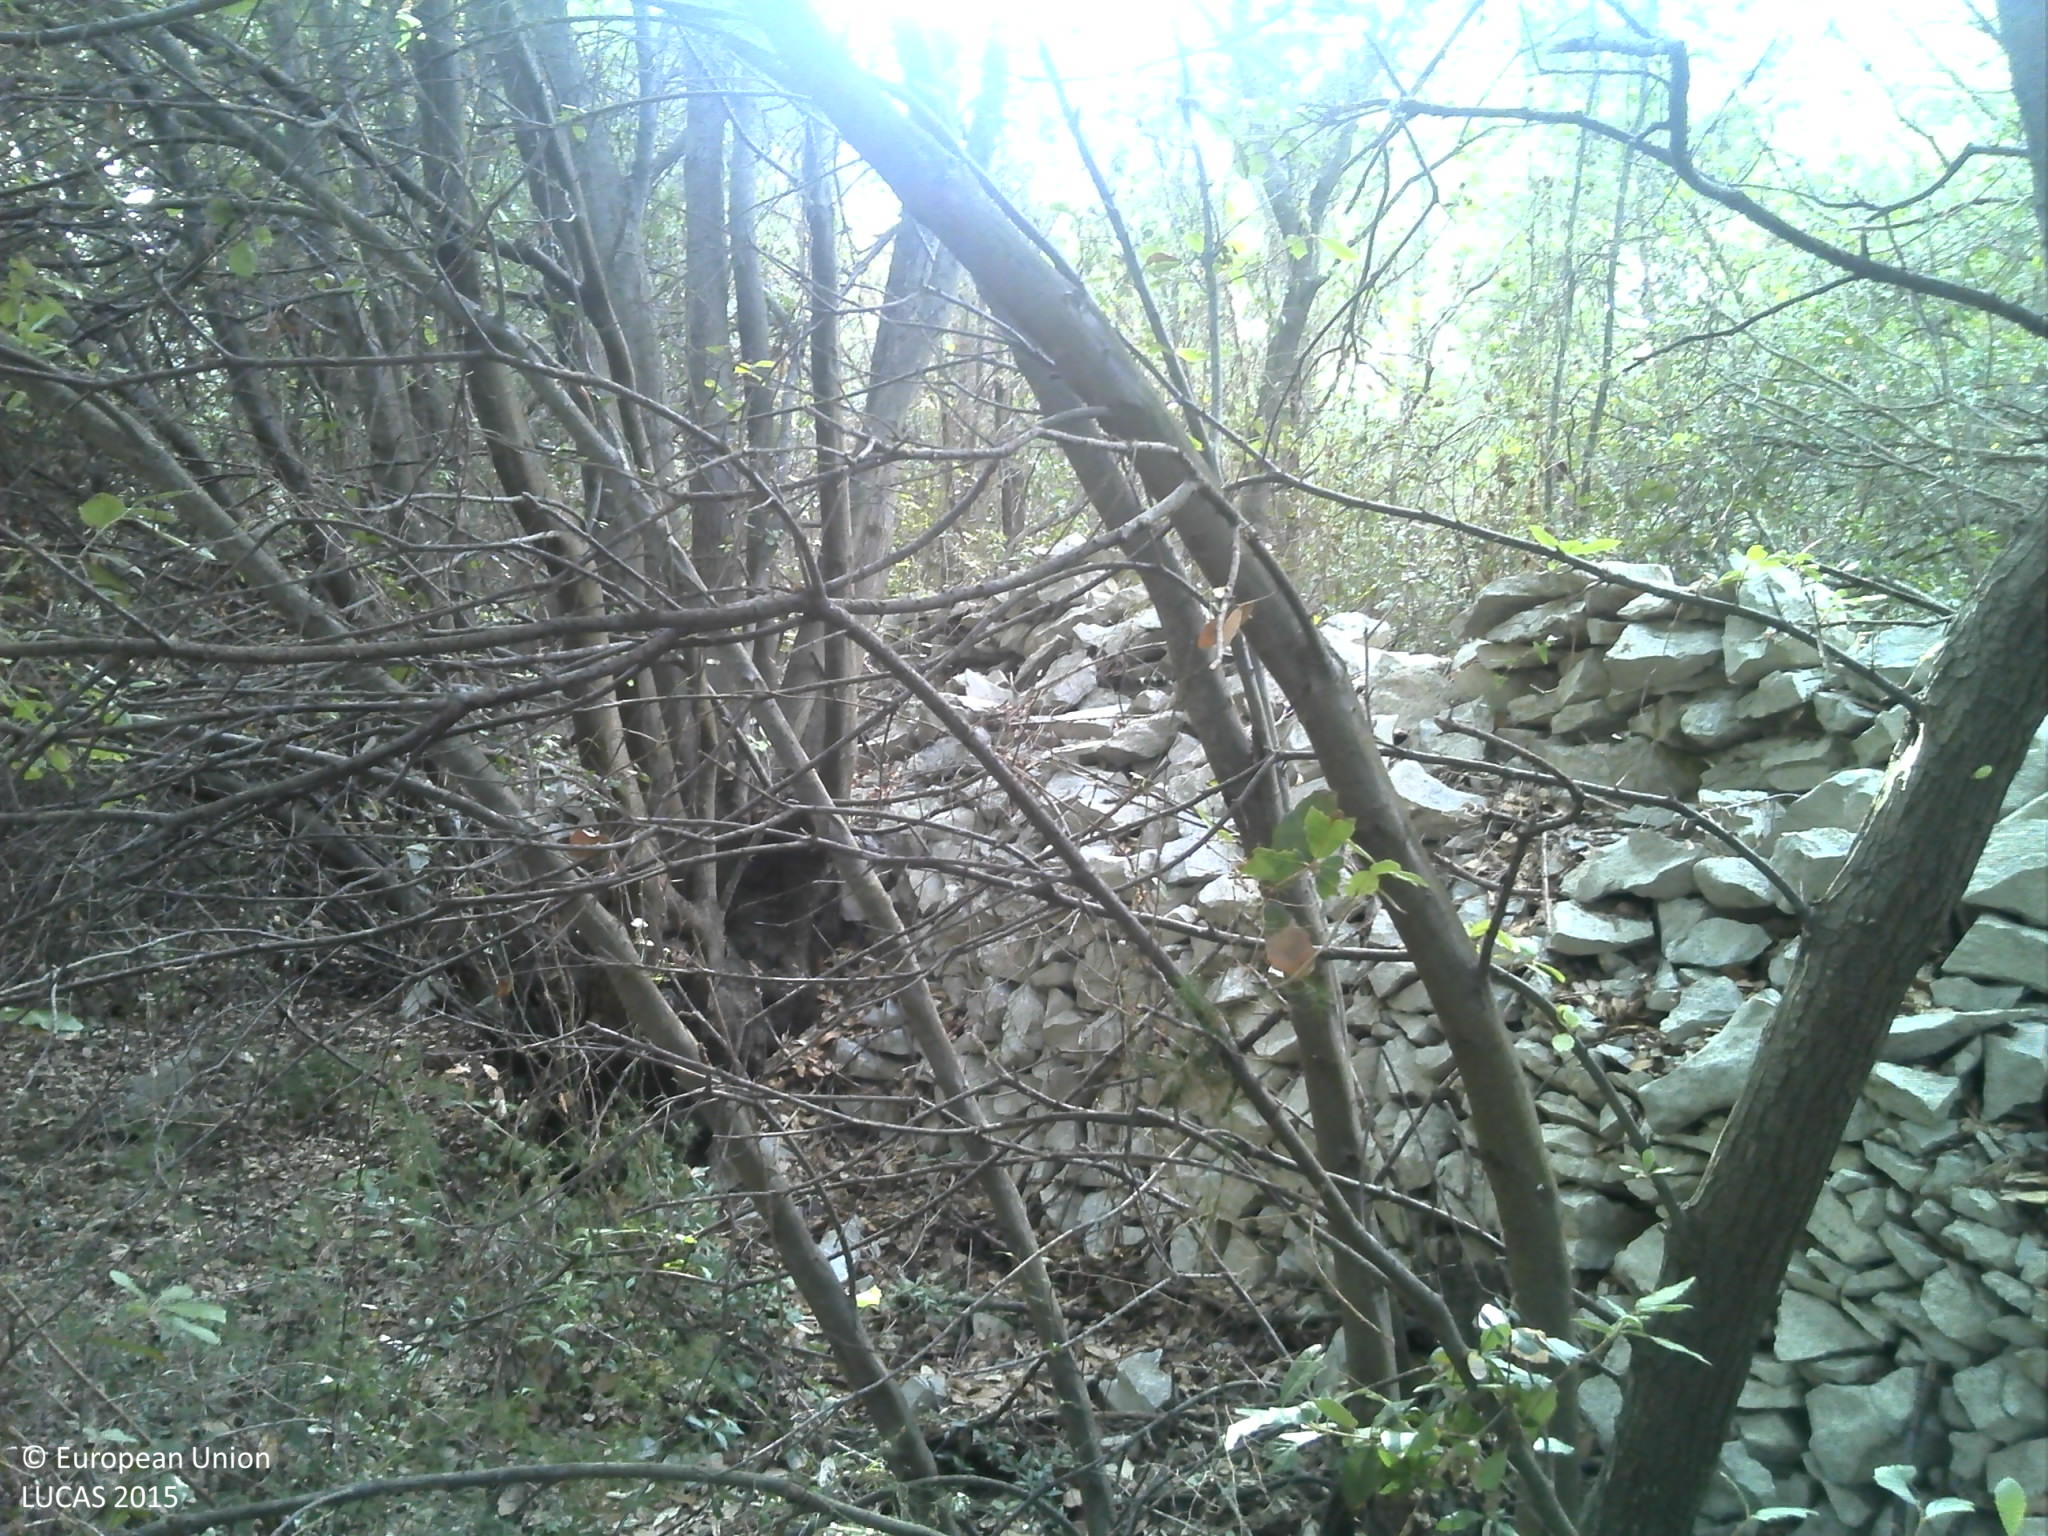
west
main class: Woodland
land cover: Pine dominated coniferous woodland
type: coniferous forest of the mediterranean region
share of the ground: > 75 %
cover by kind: coniferous forest trees 70 %, shrubs 10 %, herbaceous plants 10 %, broadleaved forest trees 5 %, consolidated bare surface 5 %
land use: Abandoned areas
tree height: > 5 m
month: September
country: HR
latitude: 44.1466
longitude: 14.8552
